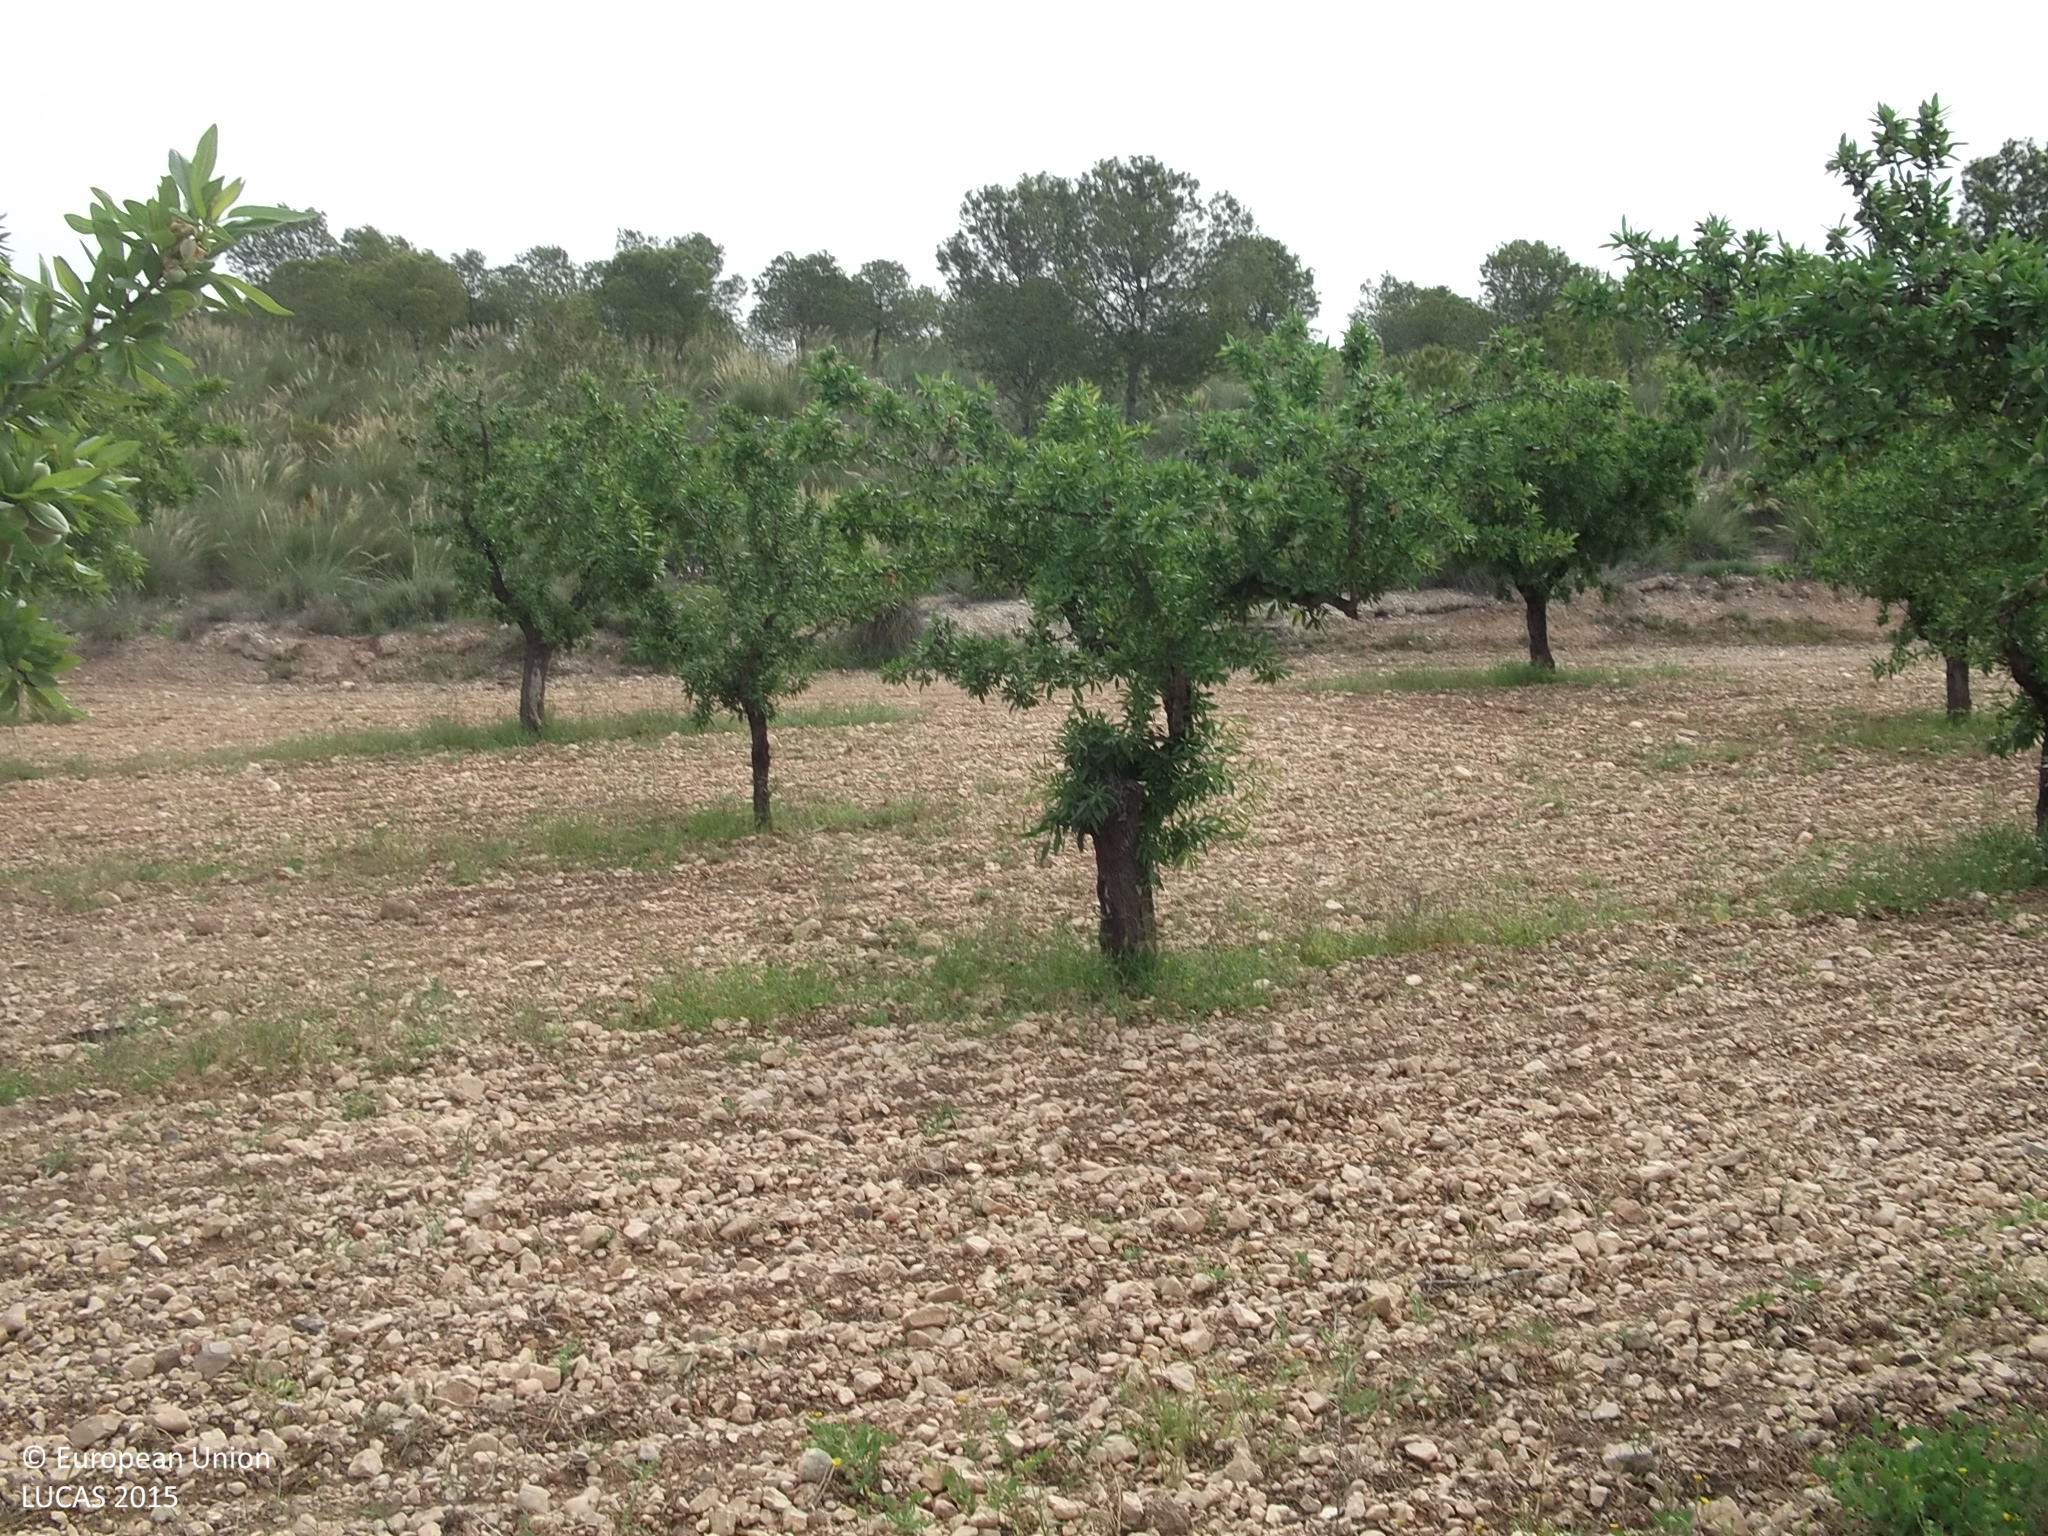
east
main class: Cropland
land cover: Nuts trees
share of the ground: 10 - 25 %
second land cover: Other bare soil
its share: > 75 %
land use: Agriculture (excluding fallow land and kitchen gardens)
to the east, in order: Nuts trees; Other bare soil; Pine dominated coniferous woodland; Tracks; Nuts trees; Tracks
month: April
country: ES
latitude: 38.2746
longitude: -1.6380
